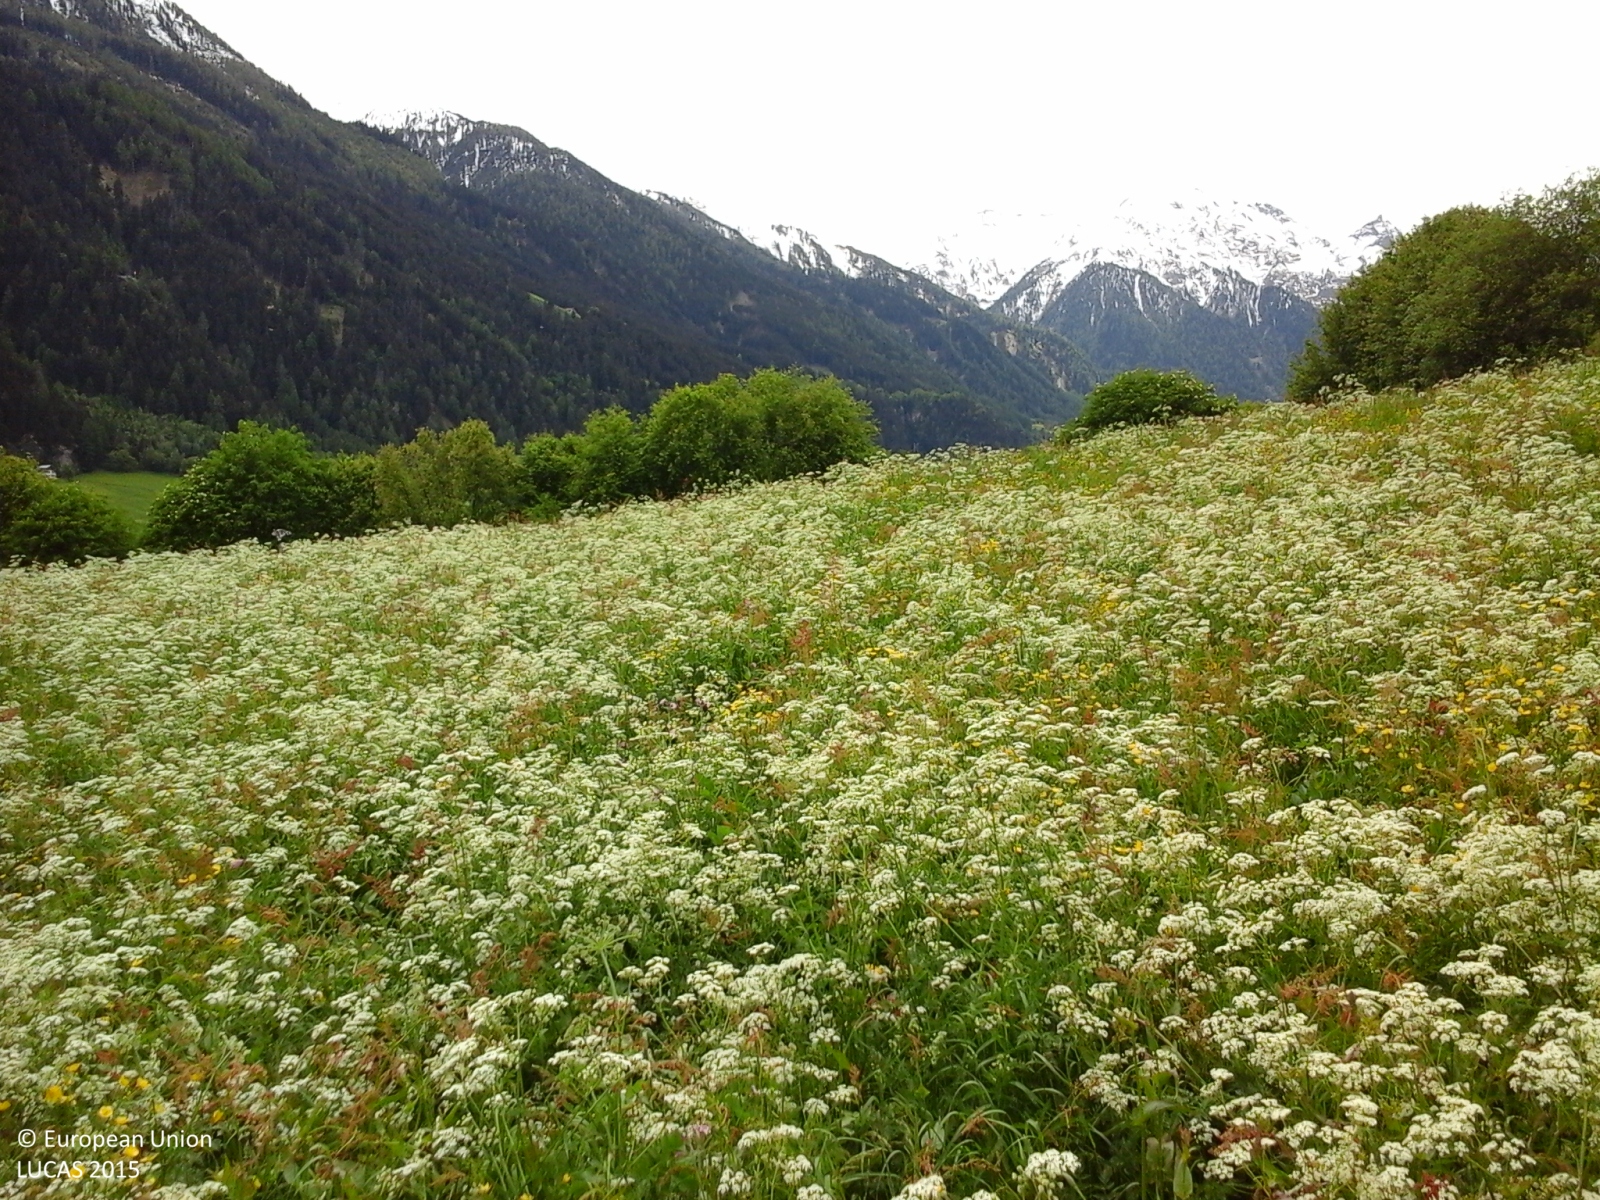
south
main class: Grassland
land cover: Grassland without tree/shrub cover
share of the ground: > 75 %
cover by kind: herbaceous plants 100 %
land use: Agriculture (excluding fallow land and kitchen gardens)
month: May
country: IT
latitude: 46.6384
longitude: 10.4567
